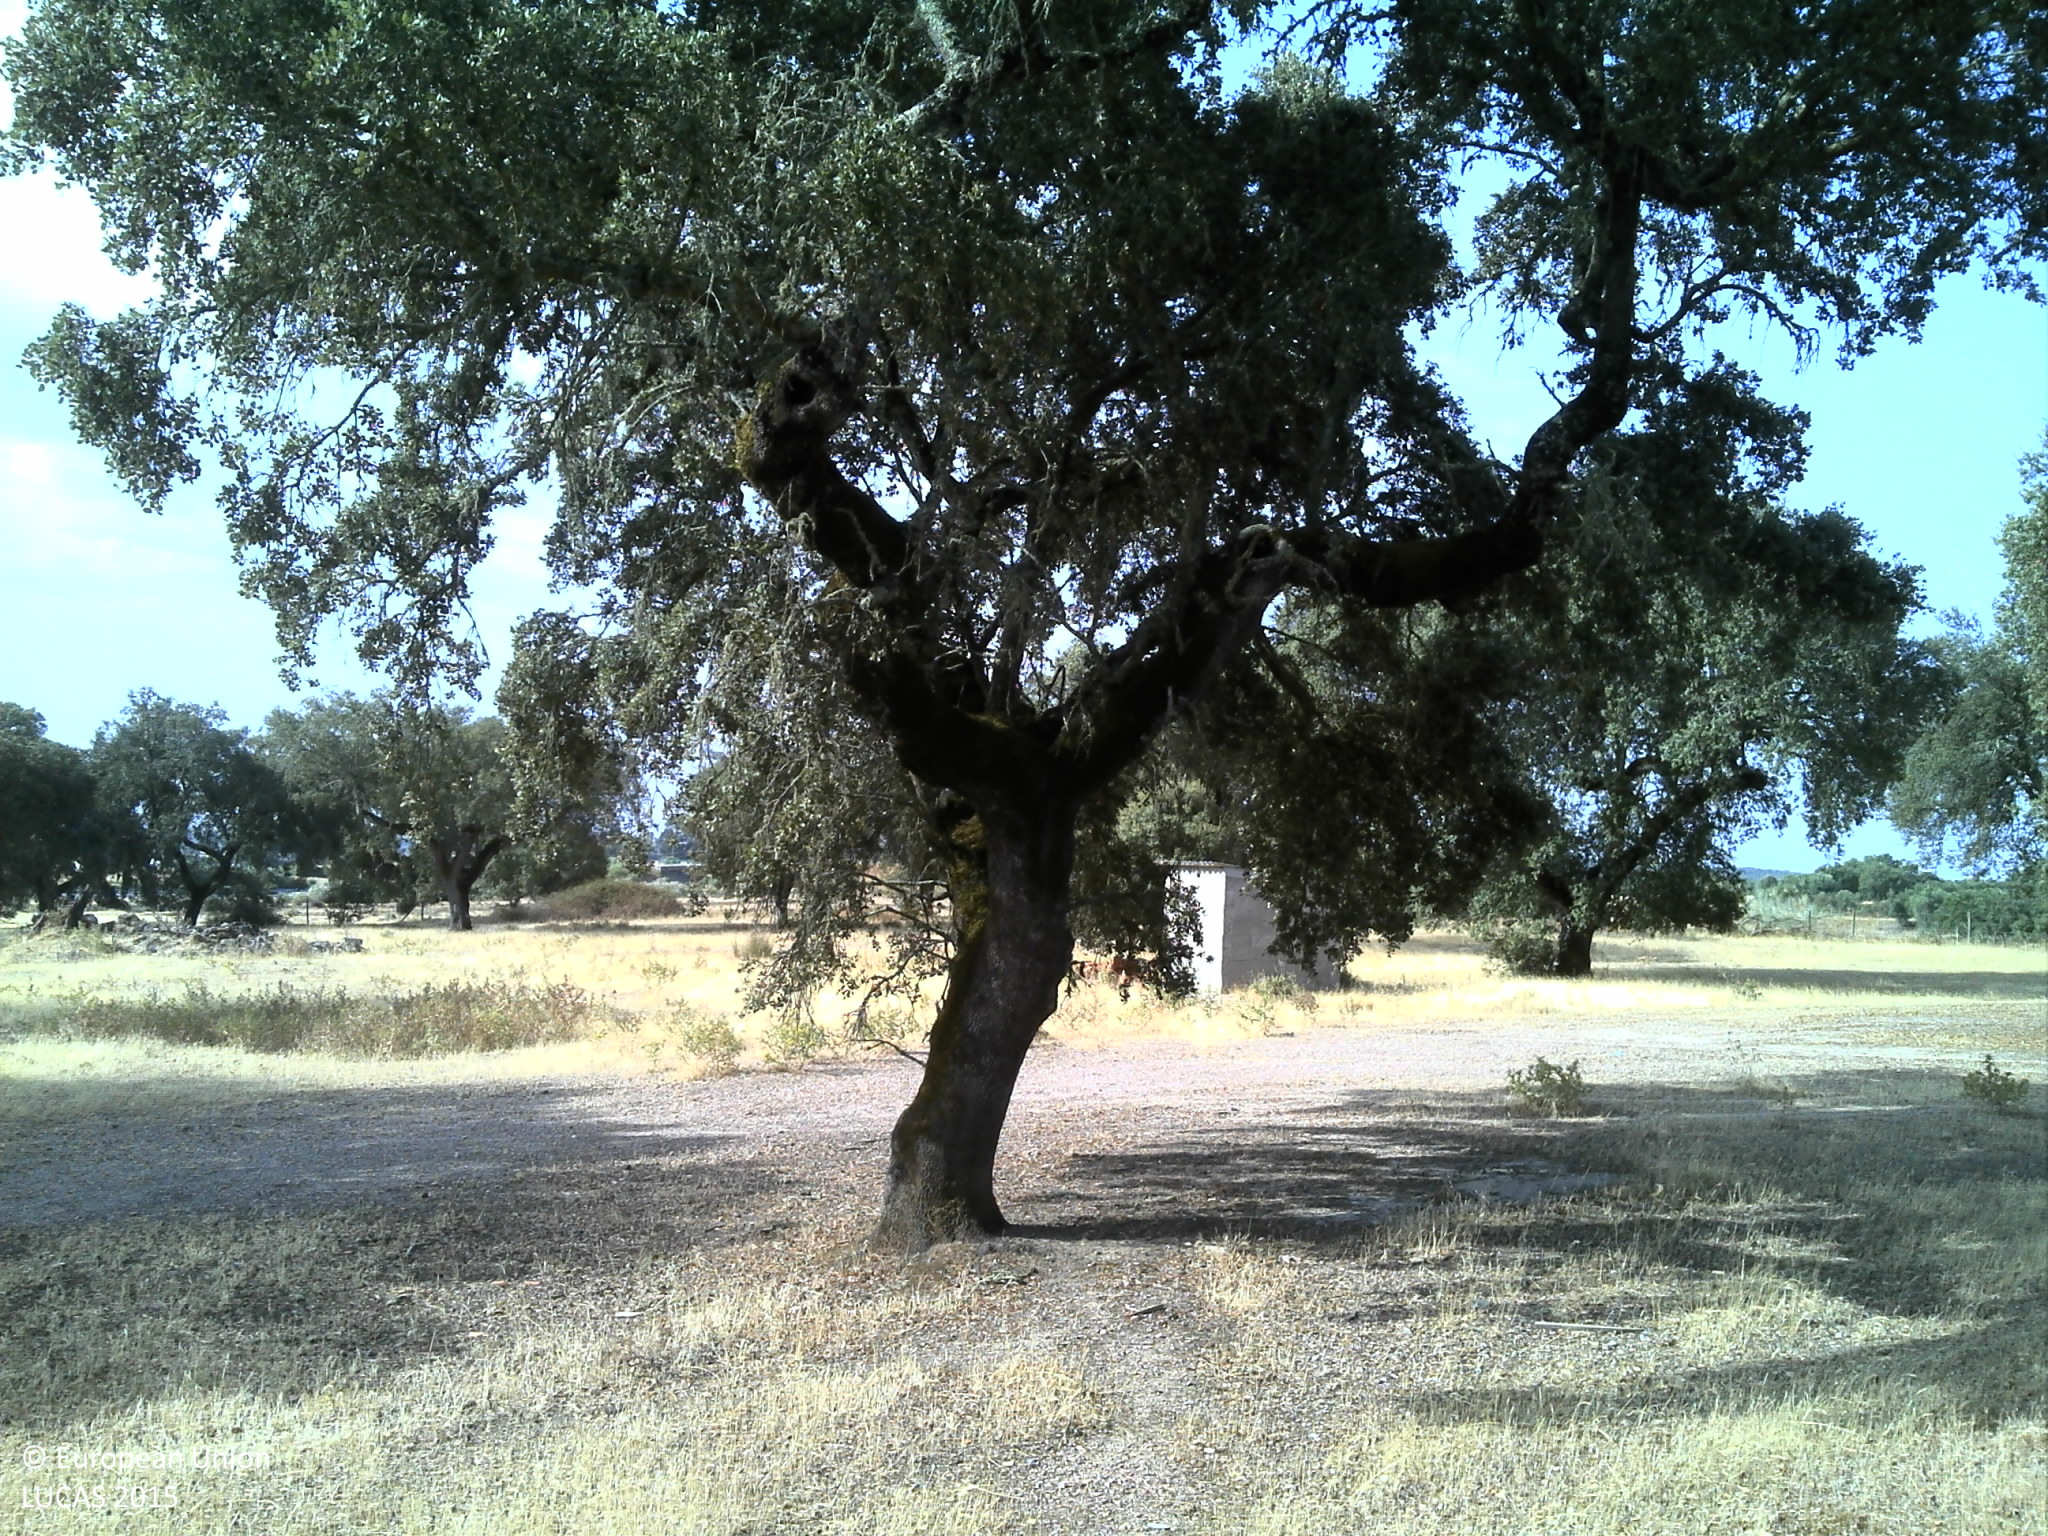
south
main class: Woodland
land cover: Broadleaved woodland
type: broadleaved evergreen forest
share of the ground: 10 - 25 %
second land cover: Grassland without tree/shrub cover
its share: 10 - 25 %
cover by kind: unconsolidated bare surface 80 %, broadleaved forest trees 10 %, herbaceous plants 10 %
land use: Forestry
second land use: Agriculture (excluding fallow land and kitchen gardens)
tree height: > 5 m
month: July
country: PT
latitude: 38.7197
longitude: -7.7861
